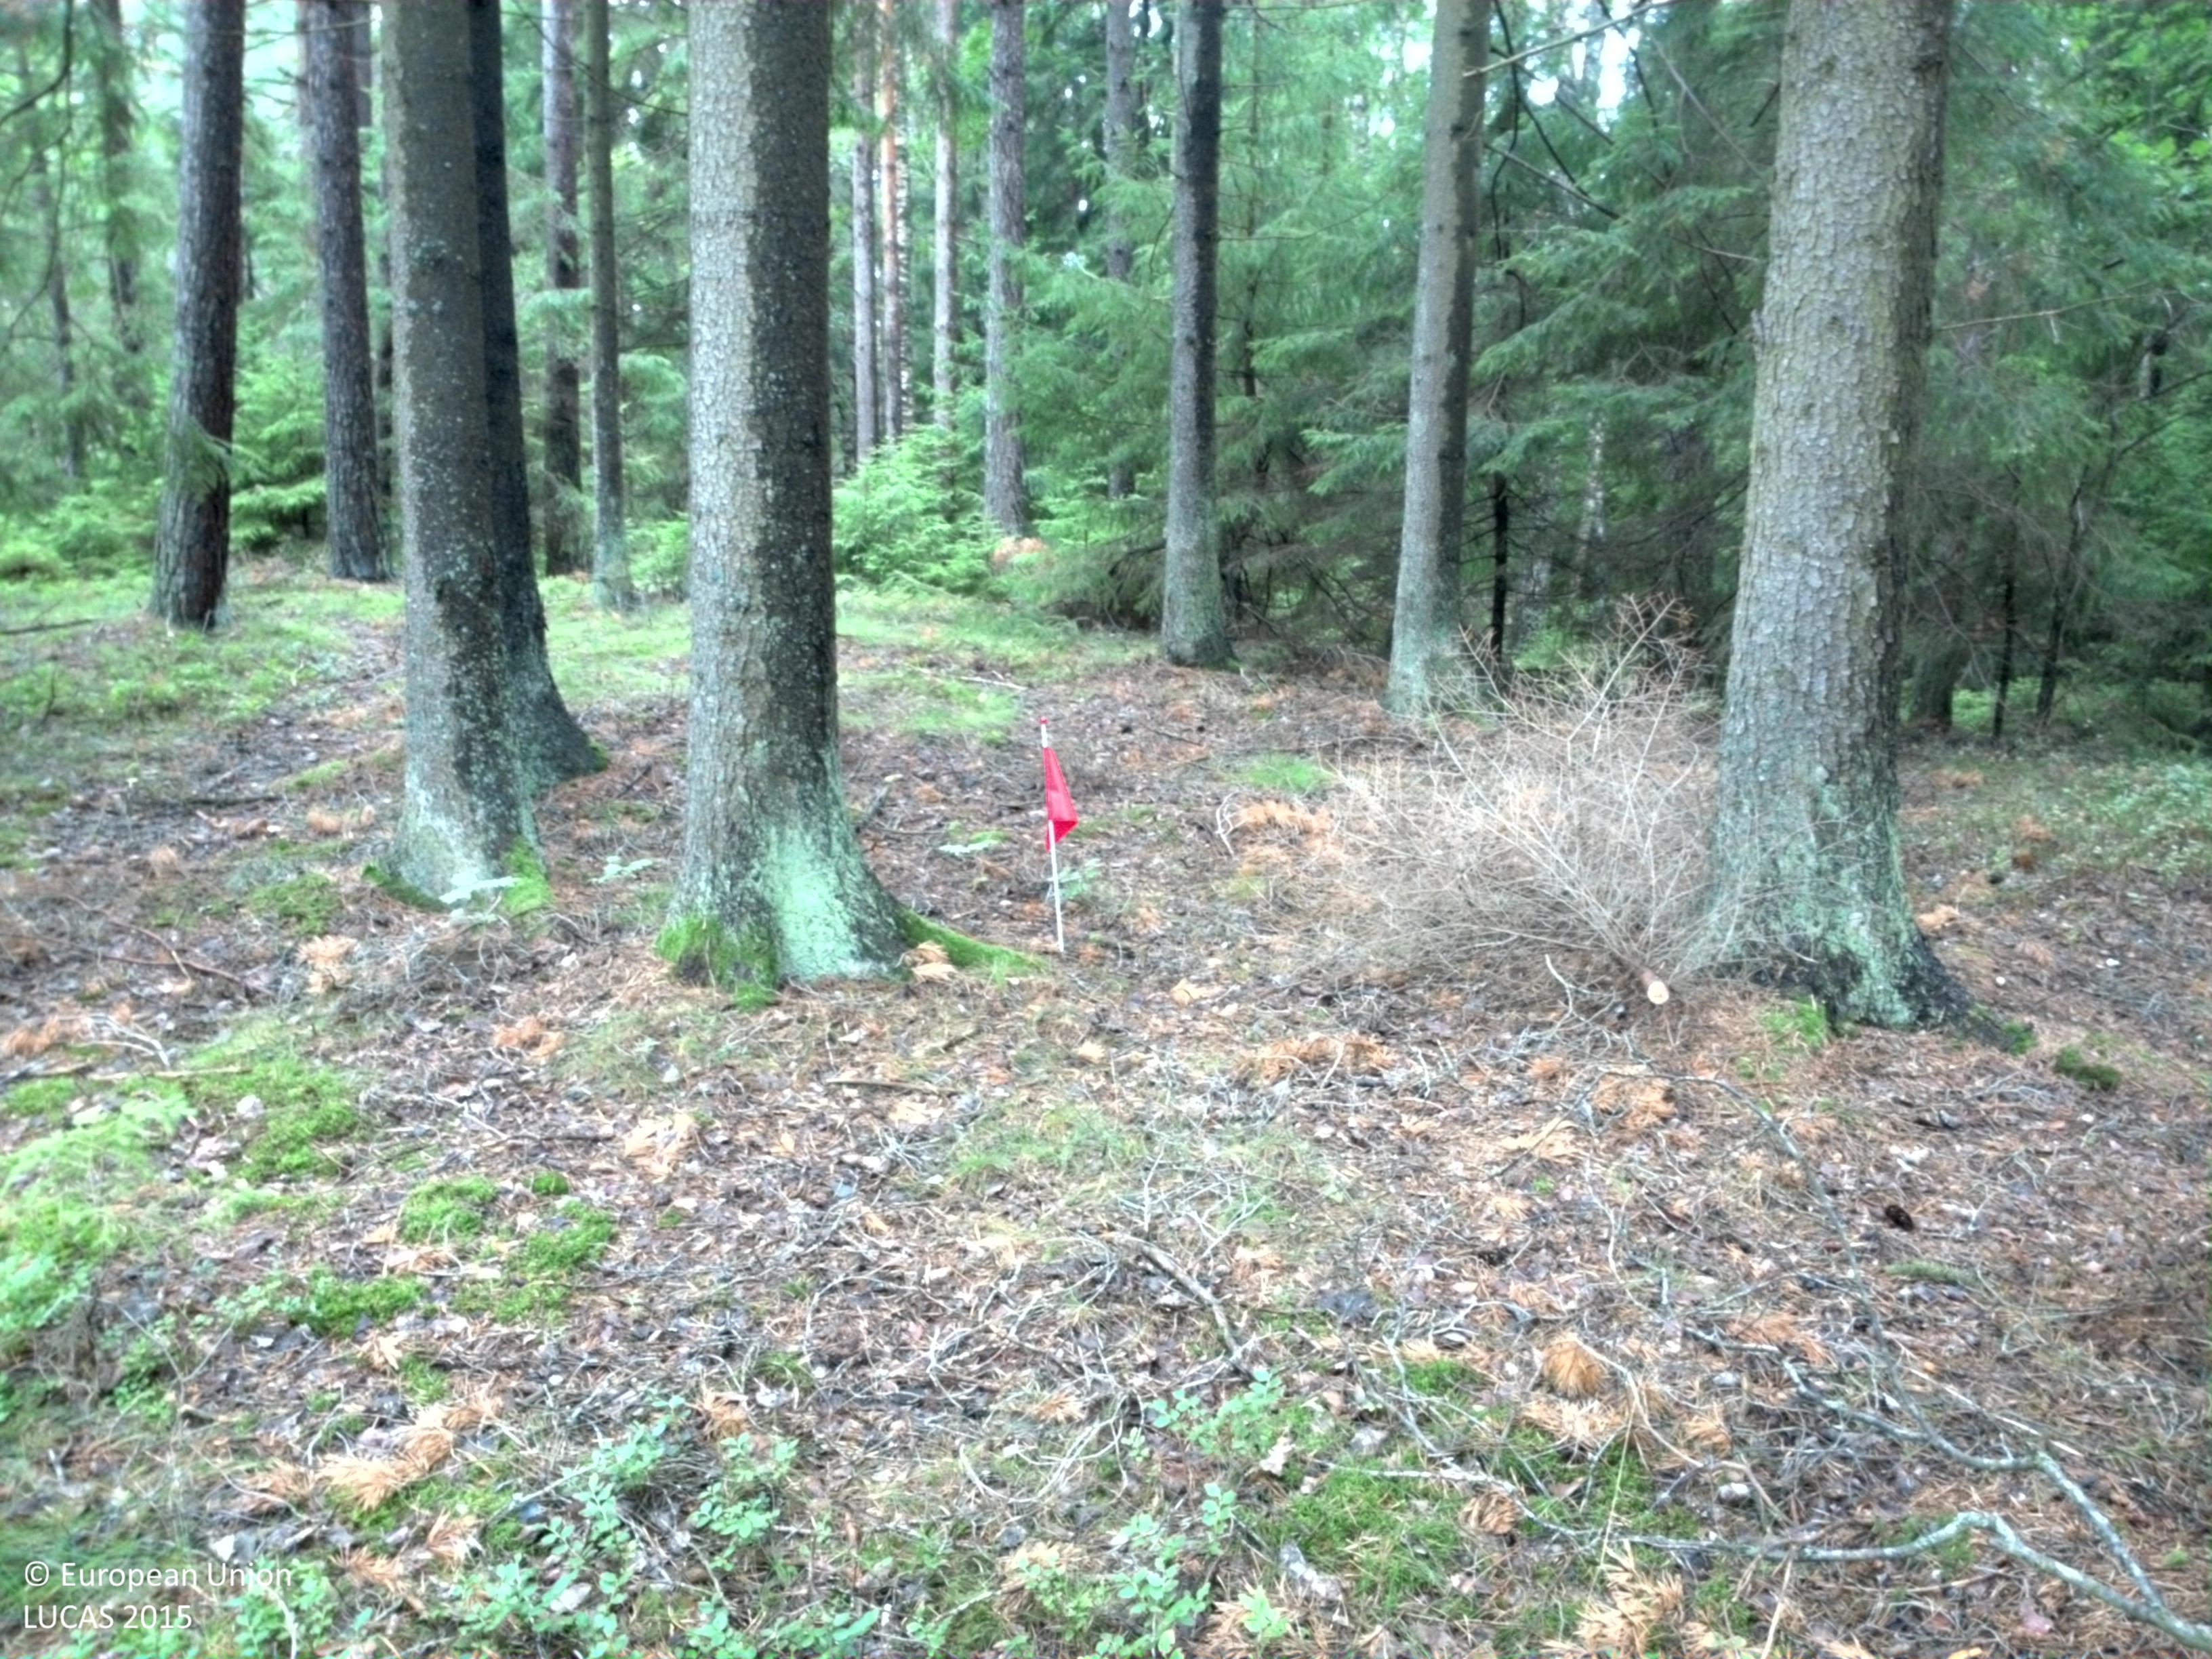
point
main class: Woodland
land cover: Spruce dominated coniferous woodland
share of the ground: > 75 %
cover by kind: coniferous forest trees 75 %, broadleaved forest trees 5 %, shrubs 5 %, herbaceous plants 5 %, lichens and mosses 5 %, unconsolidated bare surface 5 %
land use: Forestry
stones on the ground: < 10 %
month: July
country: SE
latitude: 58.4114
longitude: 13.3660
